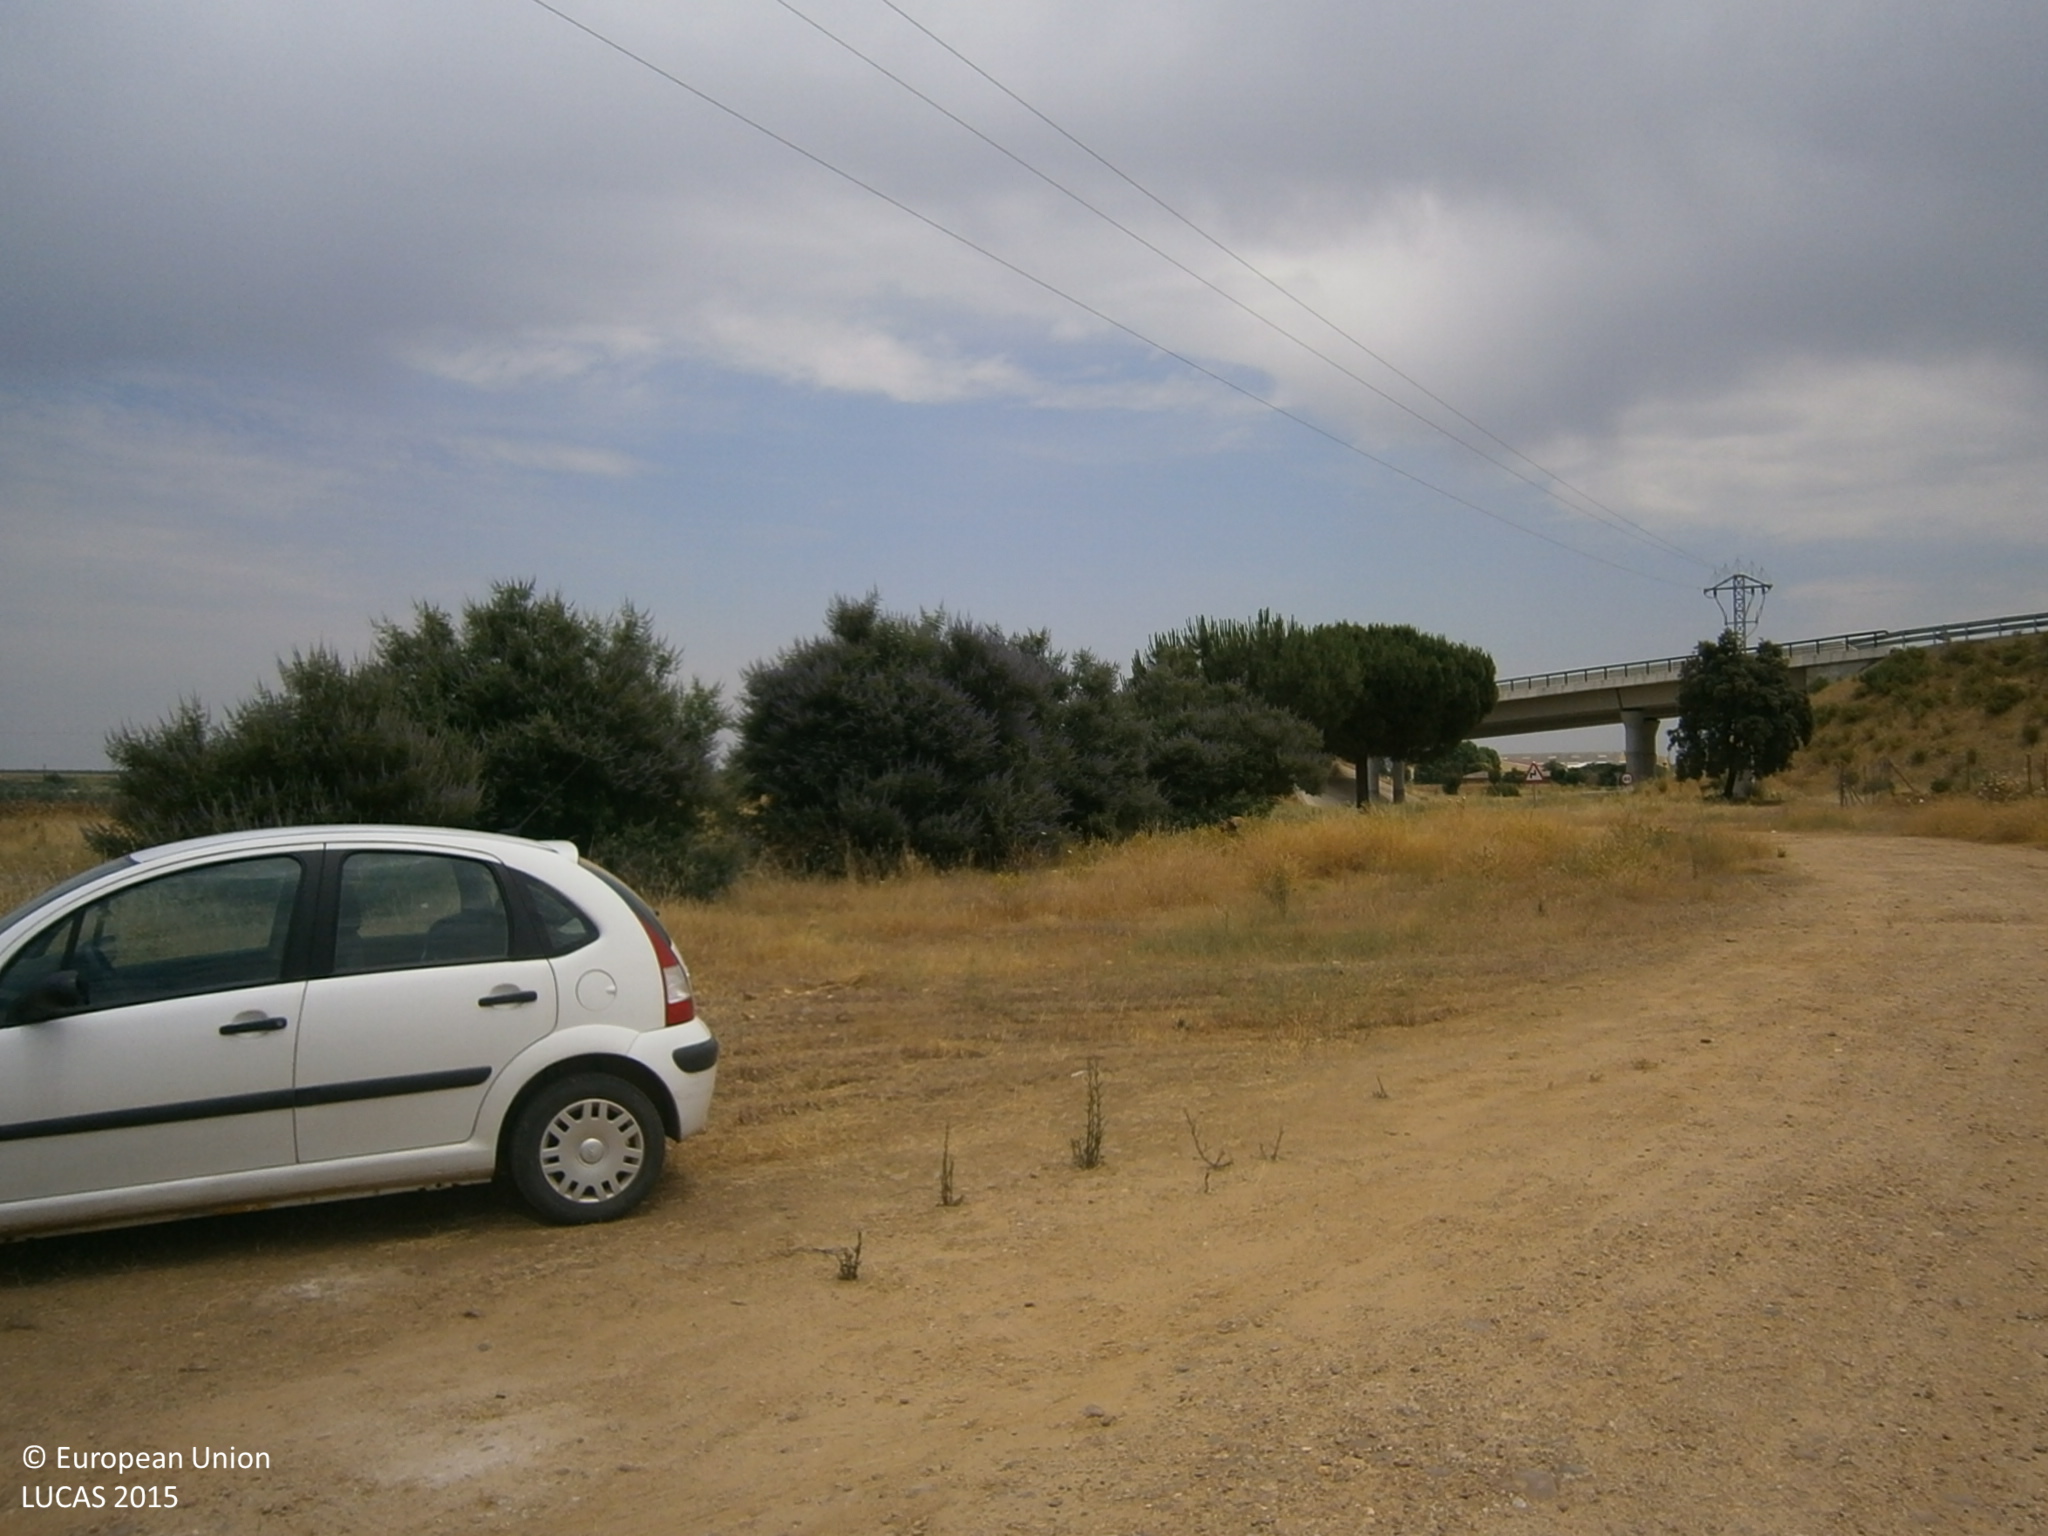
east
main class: Grassland
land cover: Grassland without tree/shrub cover
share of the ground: 25 - 50 %
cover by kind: herbaceous plants 95 %, shrubs 5 %
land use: Abandoned areas
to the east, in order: Grassland without tree/shrub cover; Other bare soil; Paved roads, cycling and walking lanes; Grassland without tree/shrub cover
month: June
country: ES
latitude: 38.9155
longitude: -6.4952
